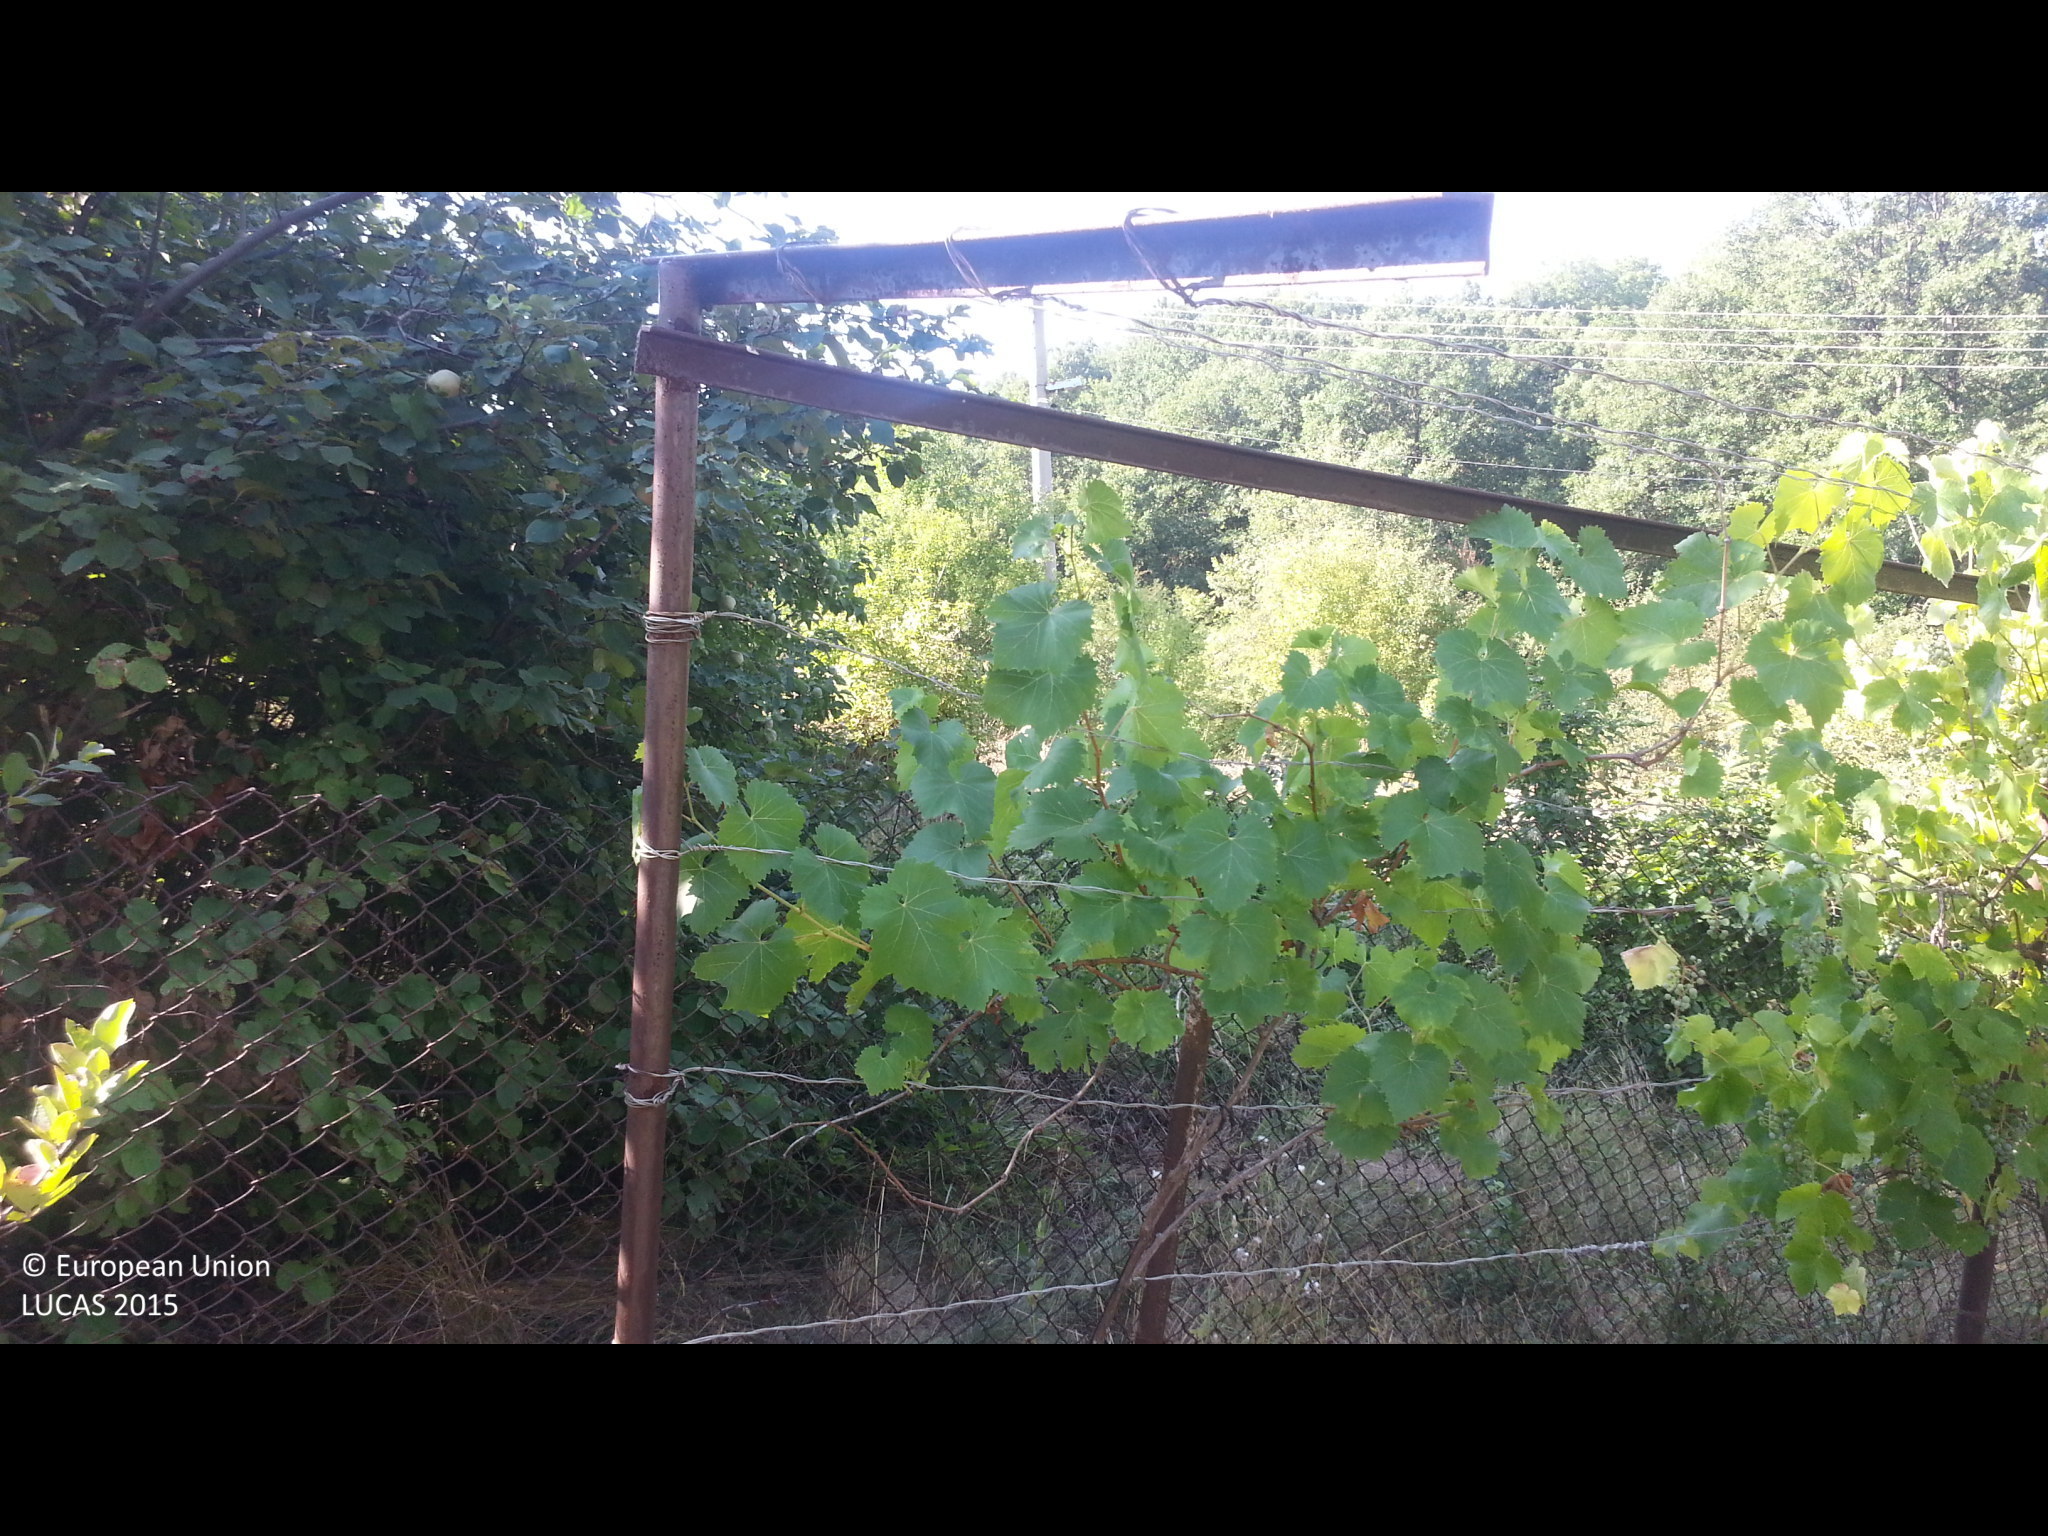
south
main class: Cropland
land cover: Pear fruit
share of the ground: 25 - 50 %
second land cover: Grassland without tree/shrub cover
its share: 50 - 75 %
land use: Kitchen garden
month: August
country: BG
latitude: 42.5619
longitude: 22.8526
